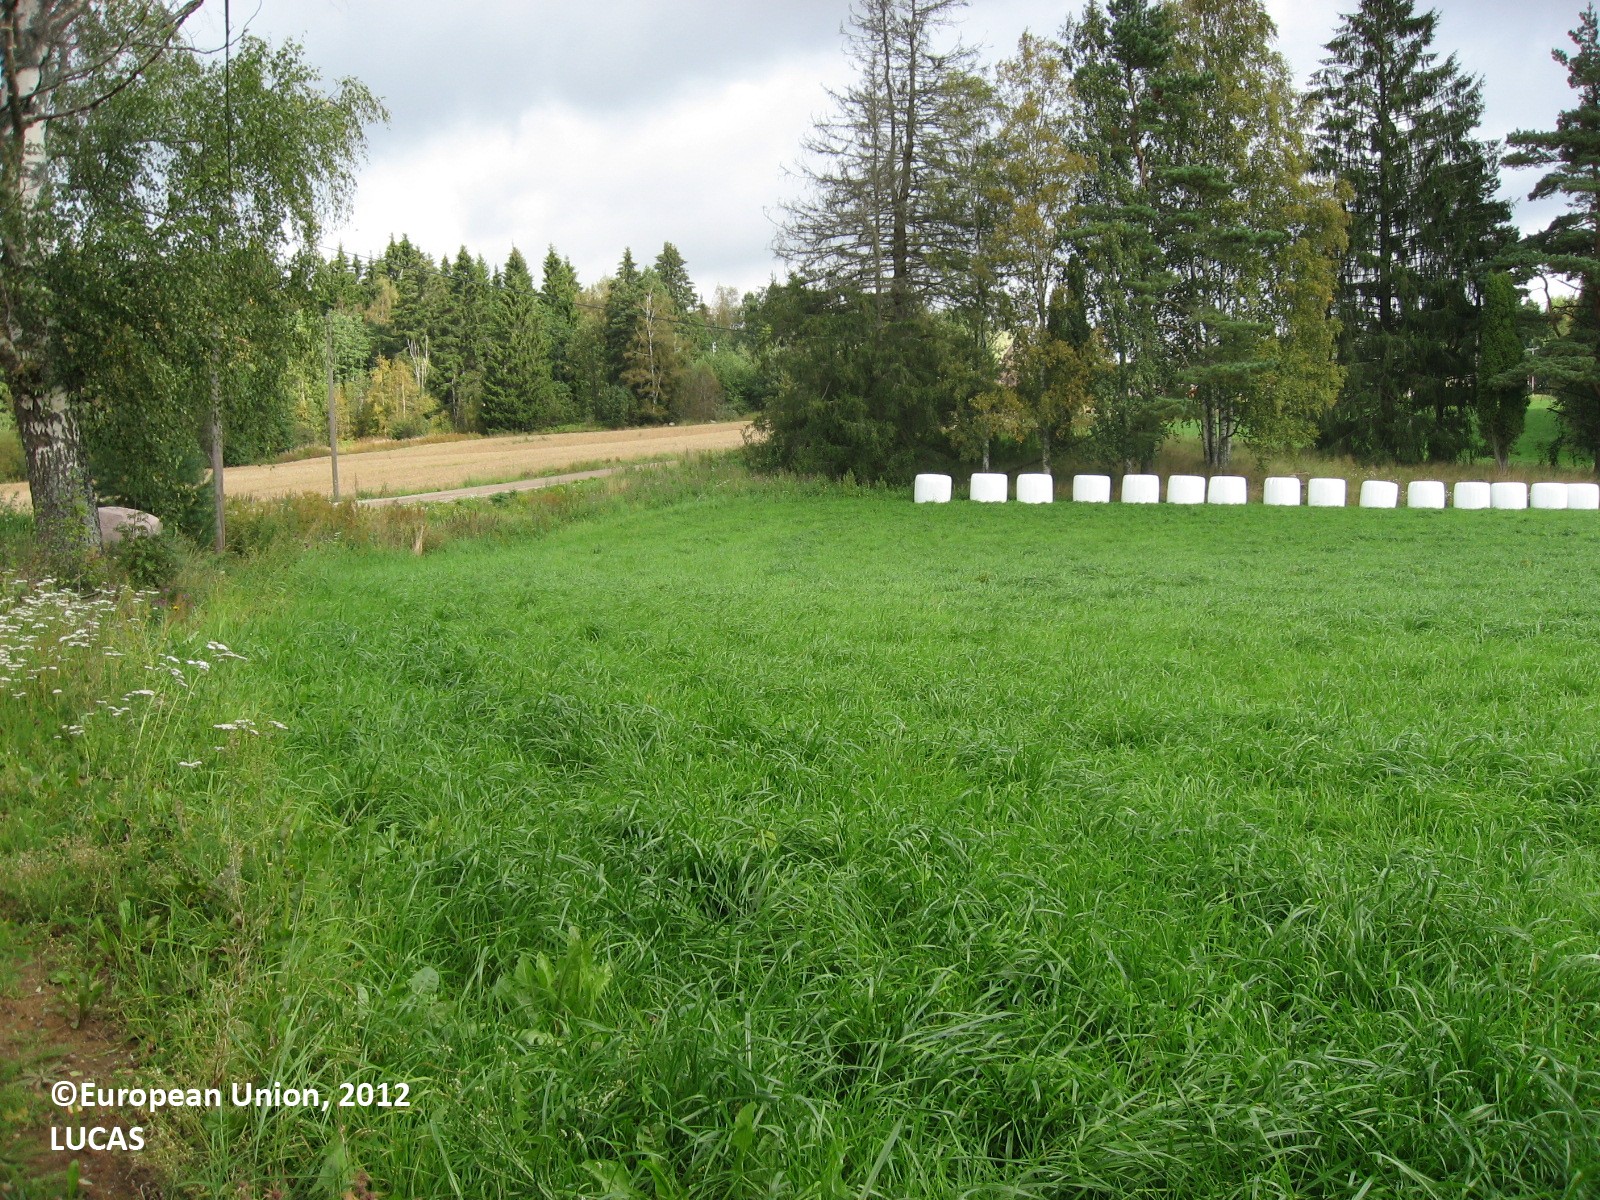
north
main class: Cropland
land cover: Temporary grasslands
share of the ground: > 75 %
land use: Agriculture (excluding fallow land and kitchen gardens)
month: September
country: FI
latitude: 60.8506
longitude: 25.2679
